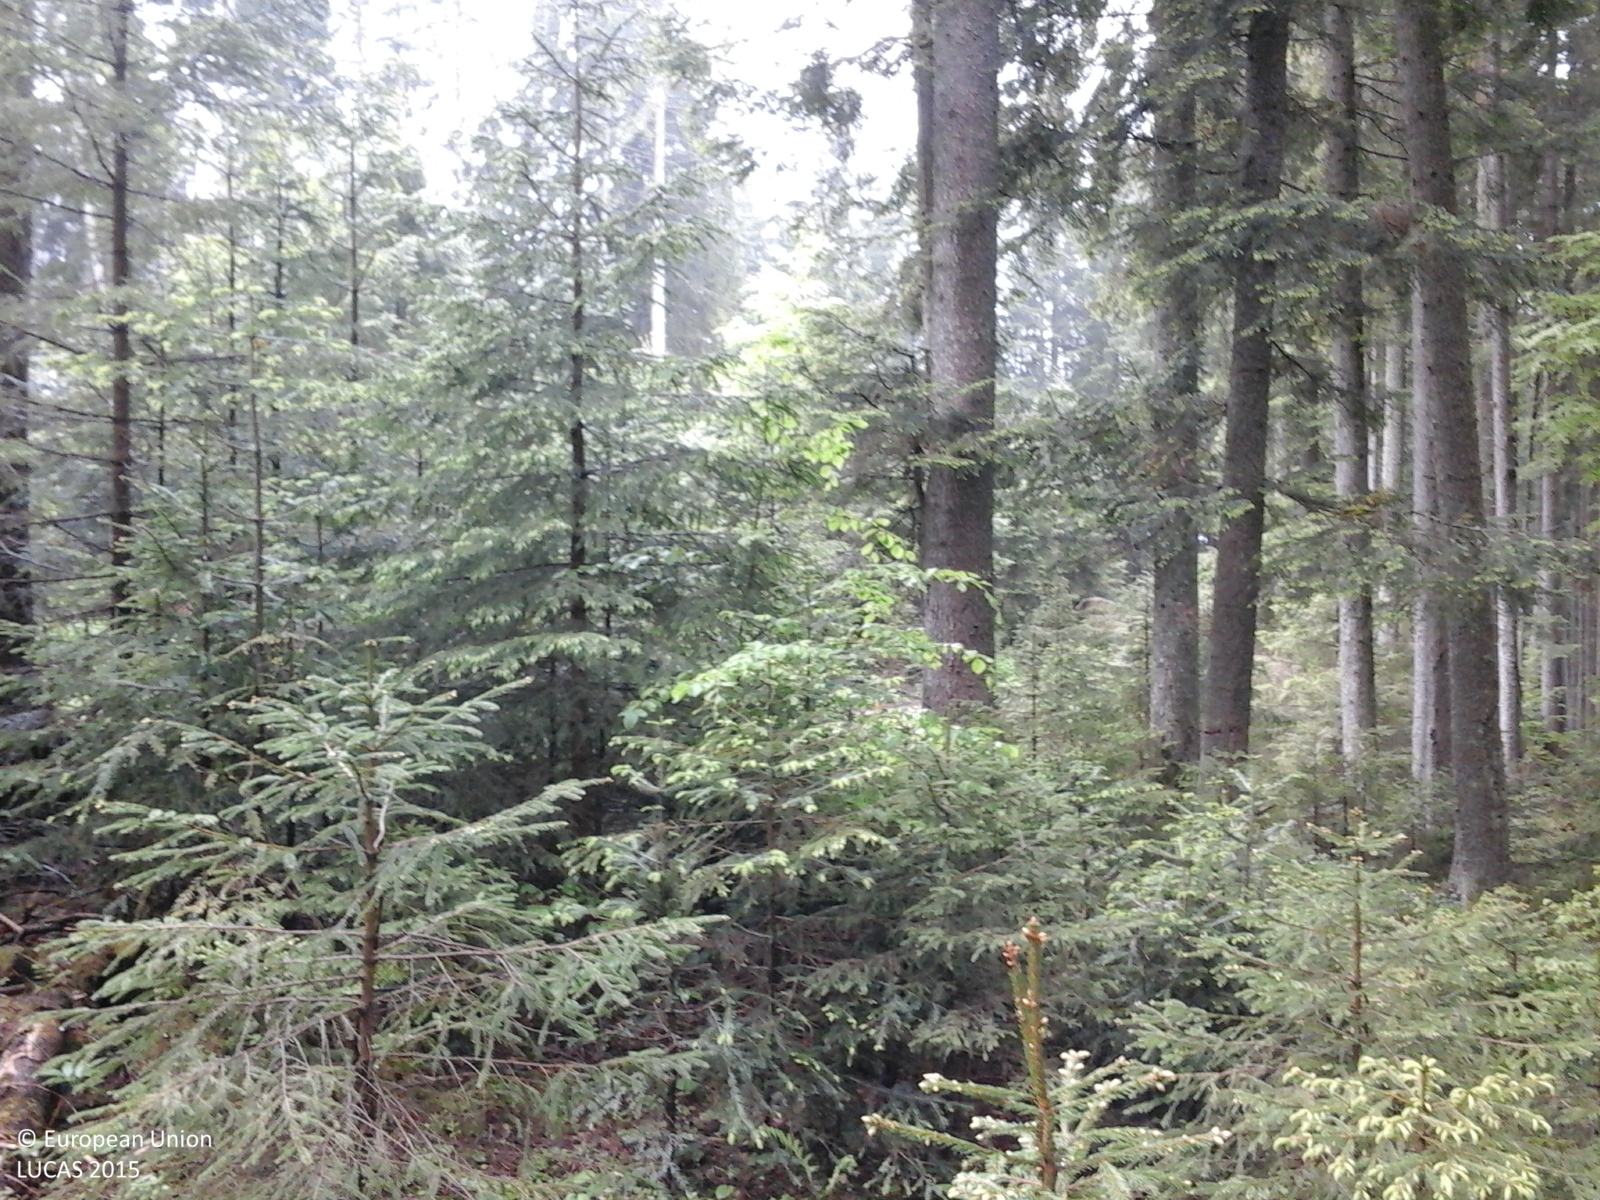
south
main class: Woodland
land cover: Spruce dominated coniferous woodland
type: alpine coniferous forest
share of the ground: > 75 %
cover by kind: coniferous forest trees 90 %, broadleaved forest trees 10 %
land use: Forestry
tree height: > 5 m
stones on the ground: < 10 %
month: May
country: RO
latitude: 45.4875
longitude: 25.6238
